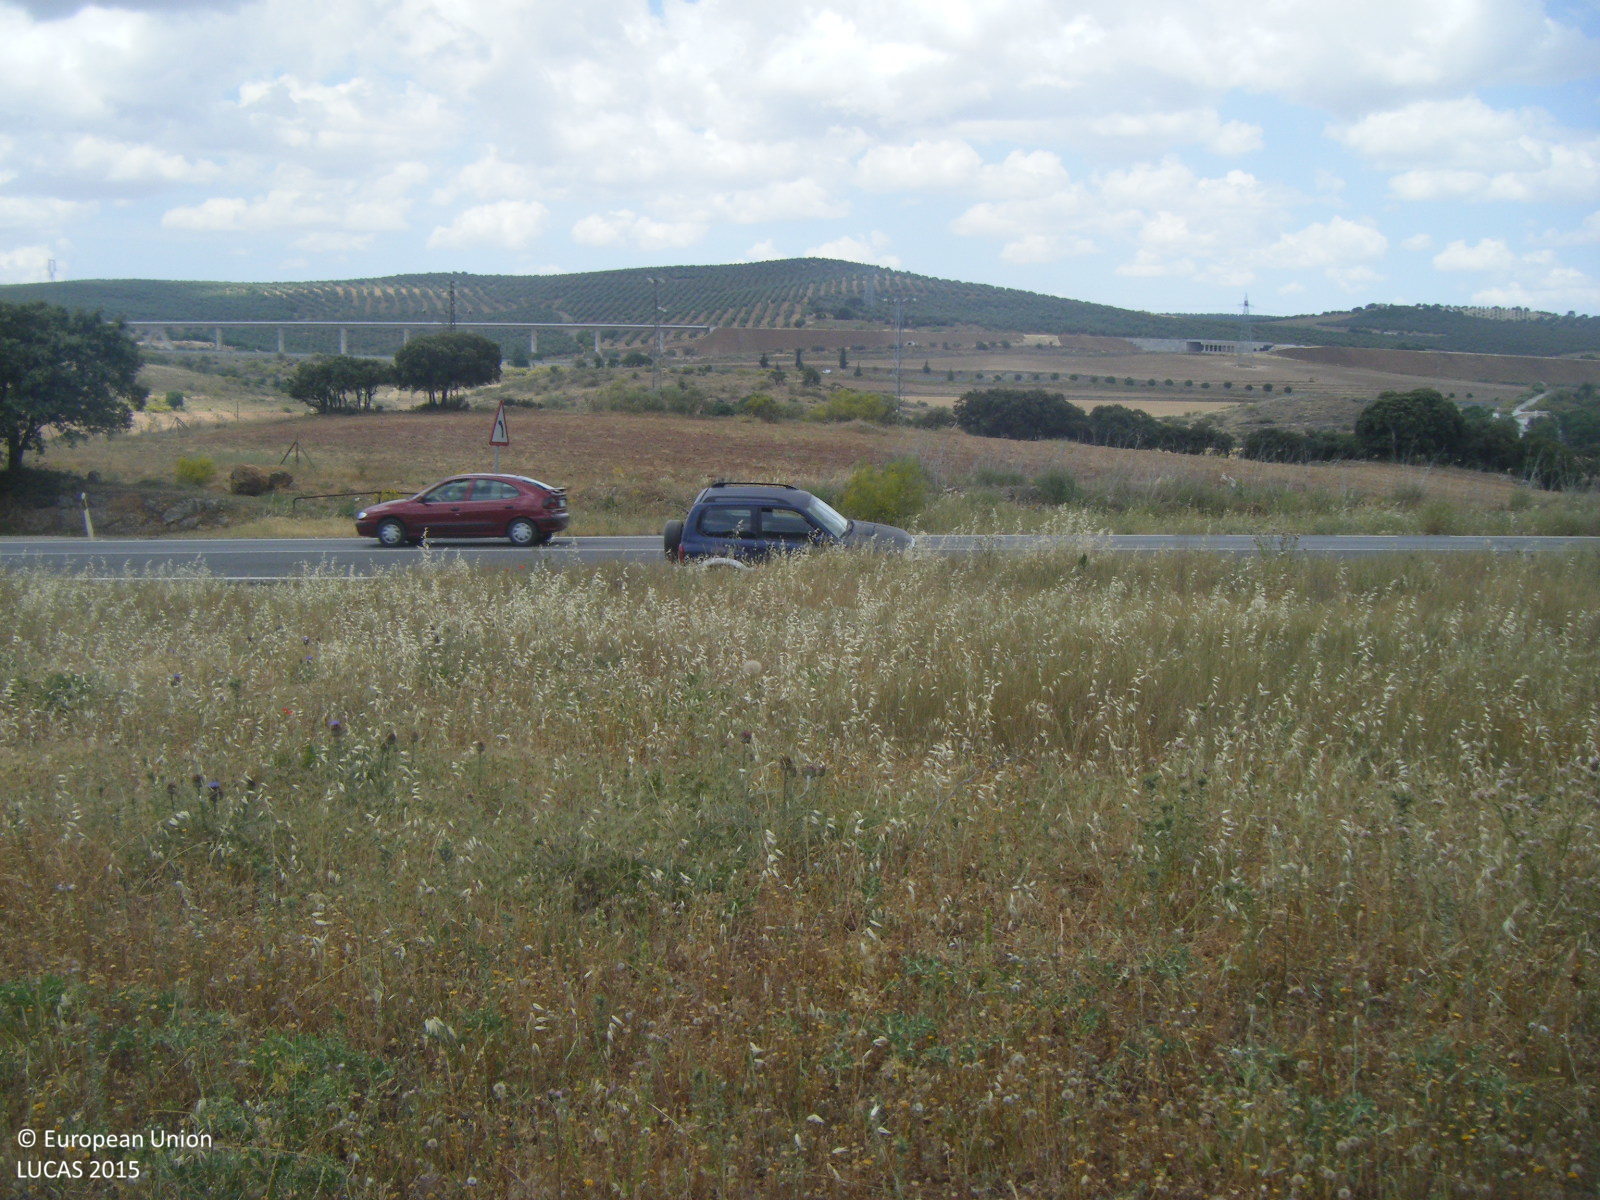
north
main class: Cropland
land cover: Nuts trees
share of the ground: 10 - 25 %
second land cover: Spontaneously vegetated surfaces
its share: > 75 %
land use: Agriculture (excluding fallow land and kitchen gardens)
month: May
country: ES
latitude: 37.0754
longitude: -4.4730
